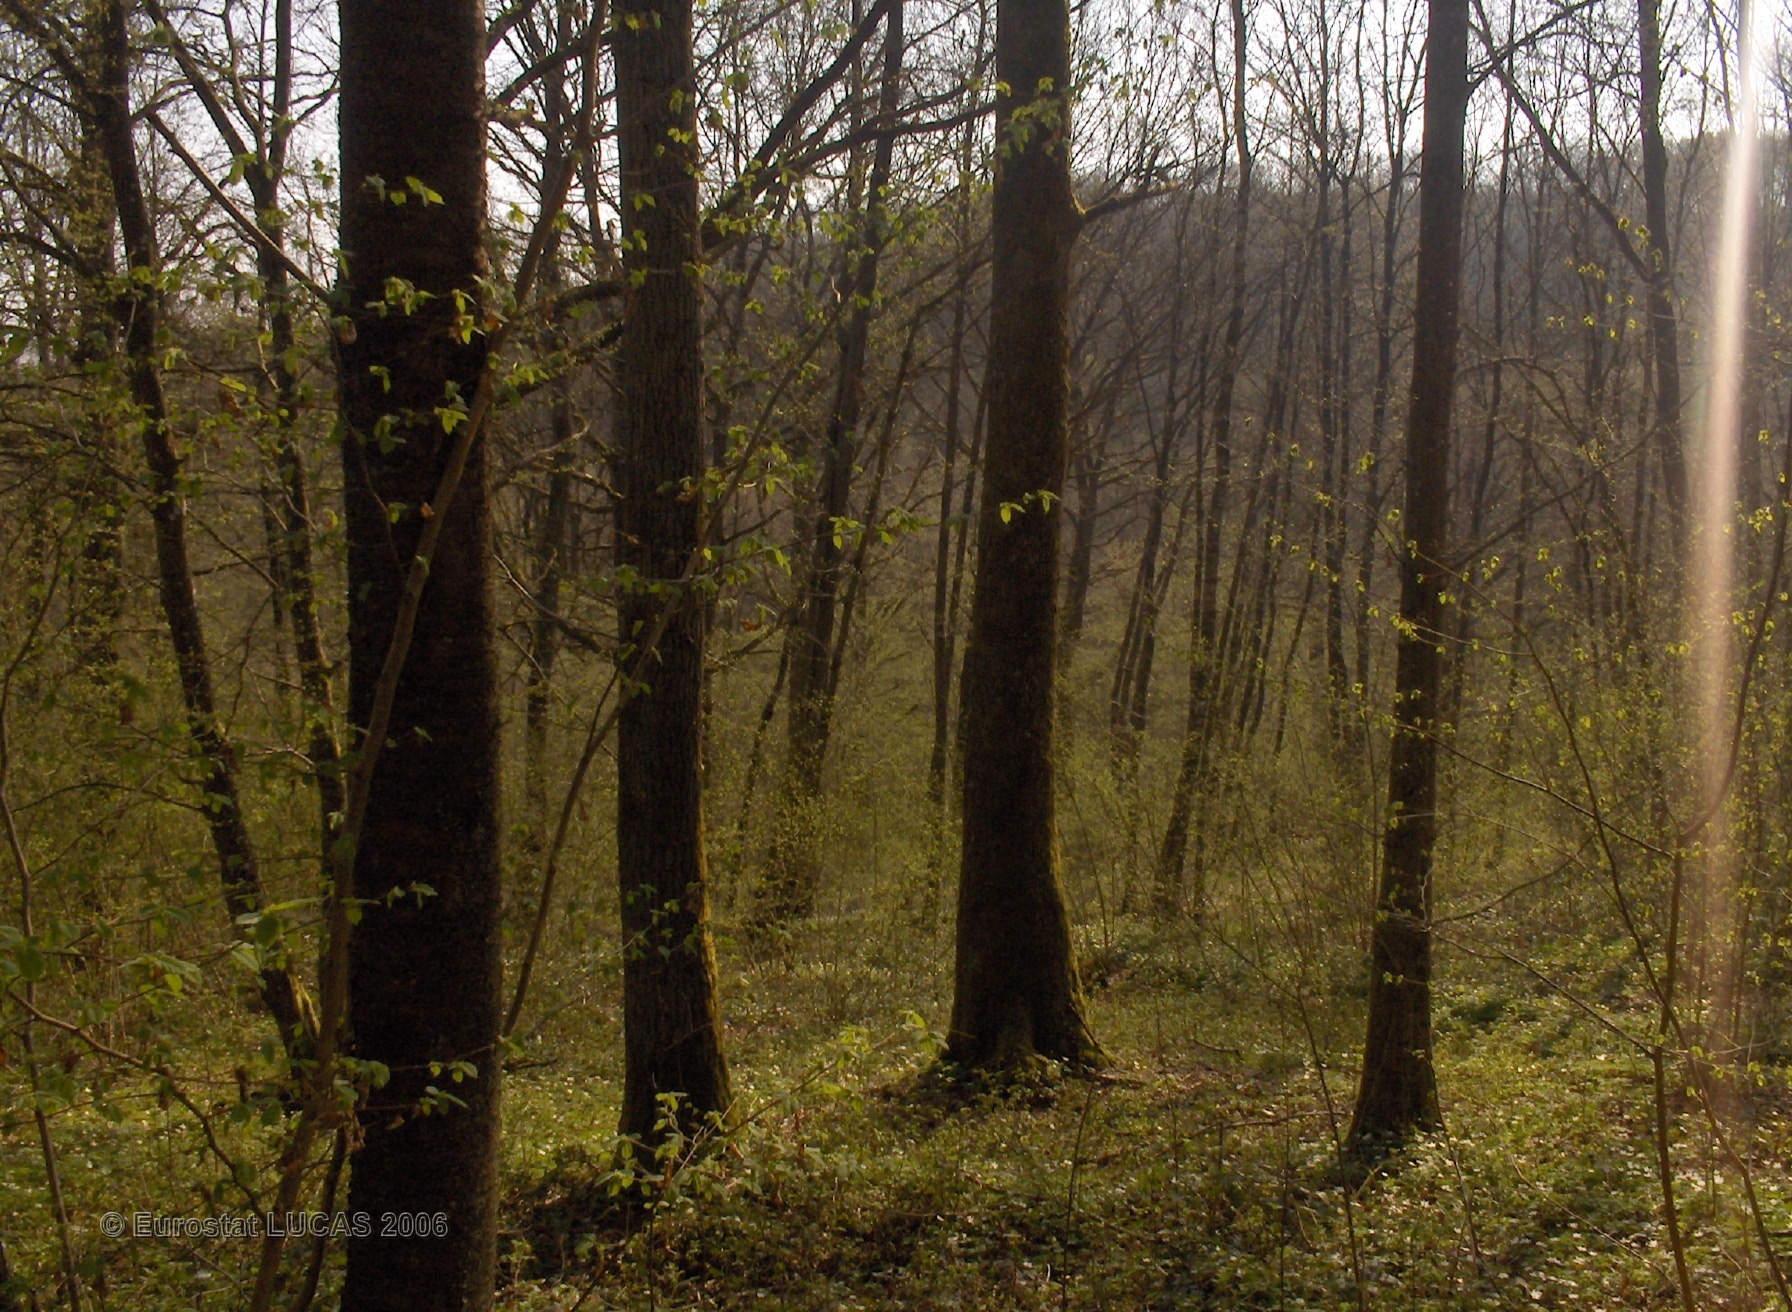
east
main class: Woodland
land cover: Broadleaved forest
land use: Forestry
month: April
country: BE
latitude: 50.0559
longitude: 4.5909
